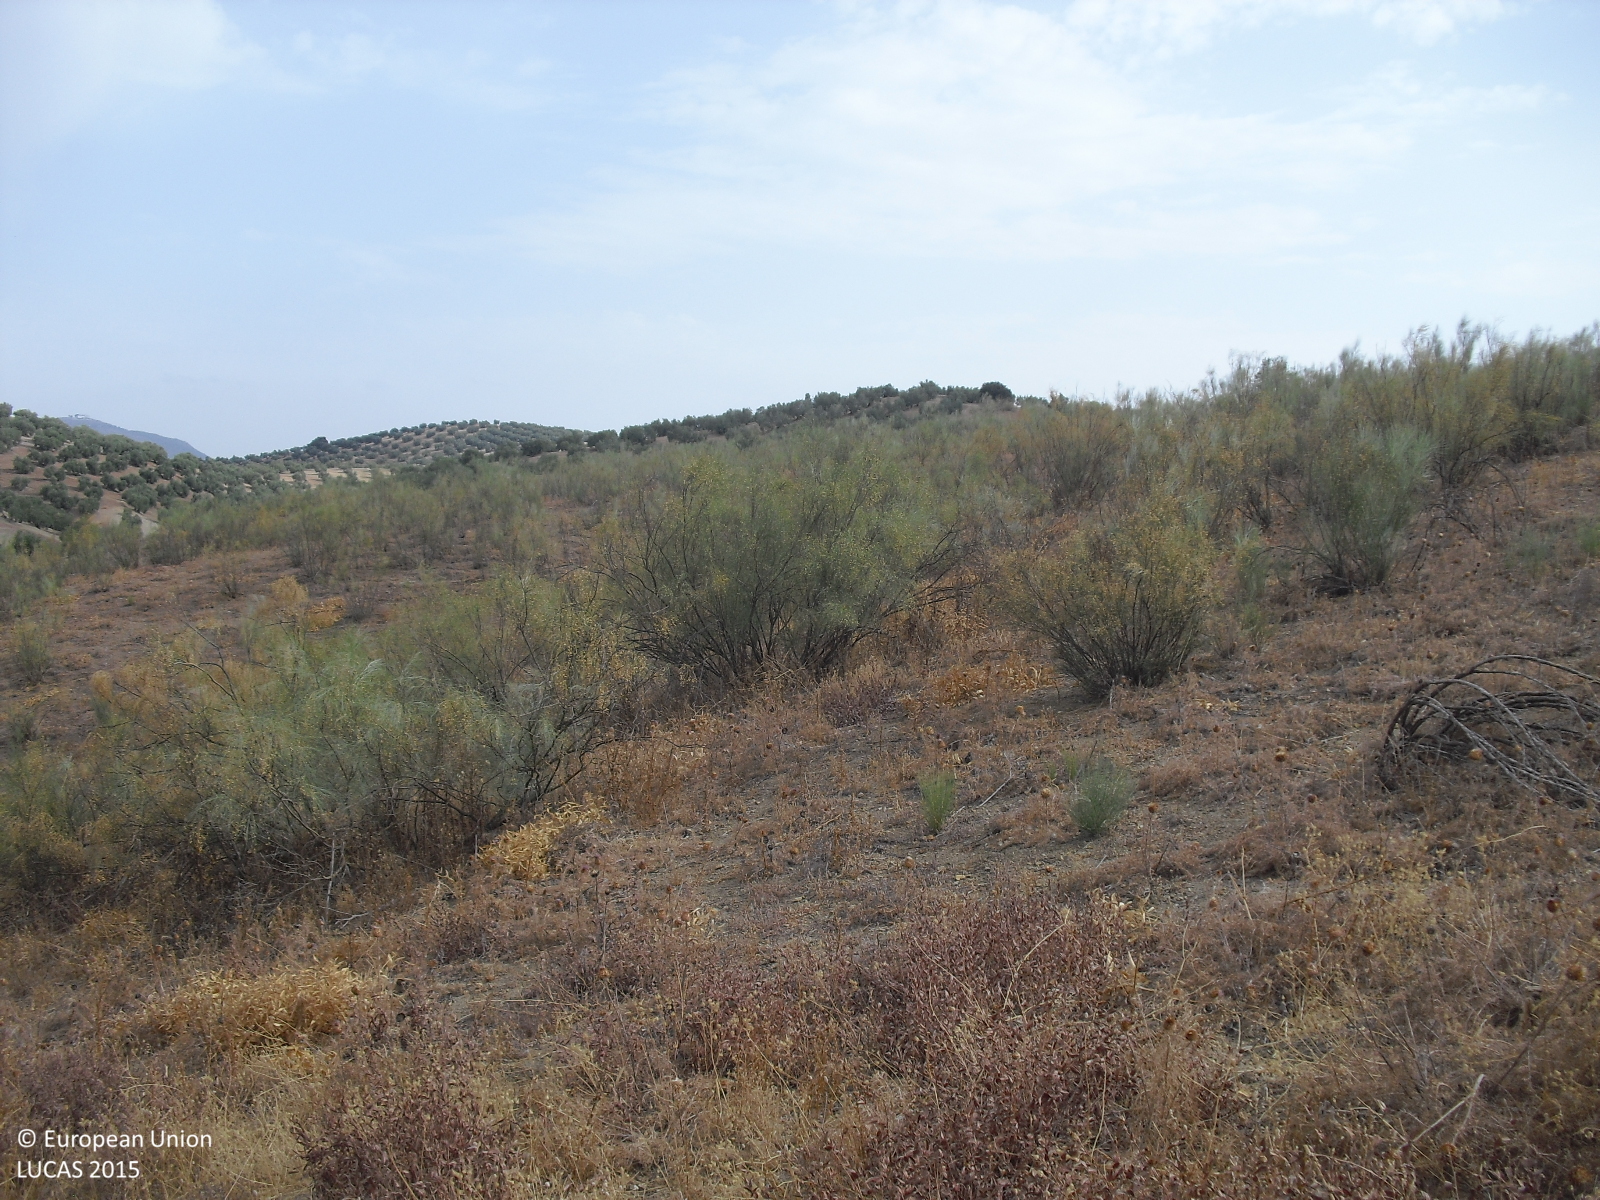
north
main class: Shrubland
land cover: Shrubland without tree cover
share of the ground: 10 - 25 %
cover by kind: herbaceous plants 75 %, shrubs 15 %, unconsolidated bare surface 10 %
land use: Semi-natural and natural areas not in use
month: August
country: ES
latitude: 37.3205
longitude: -4.4334
